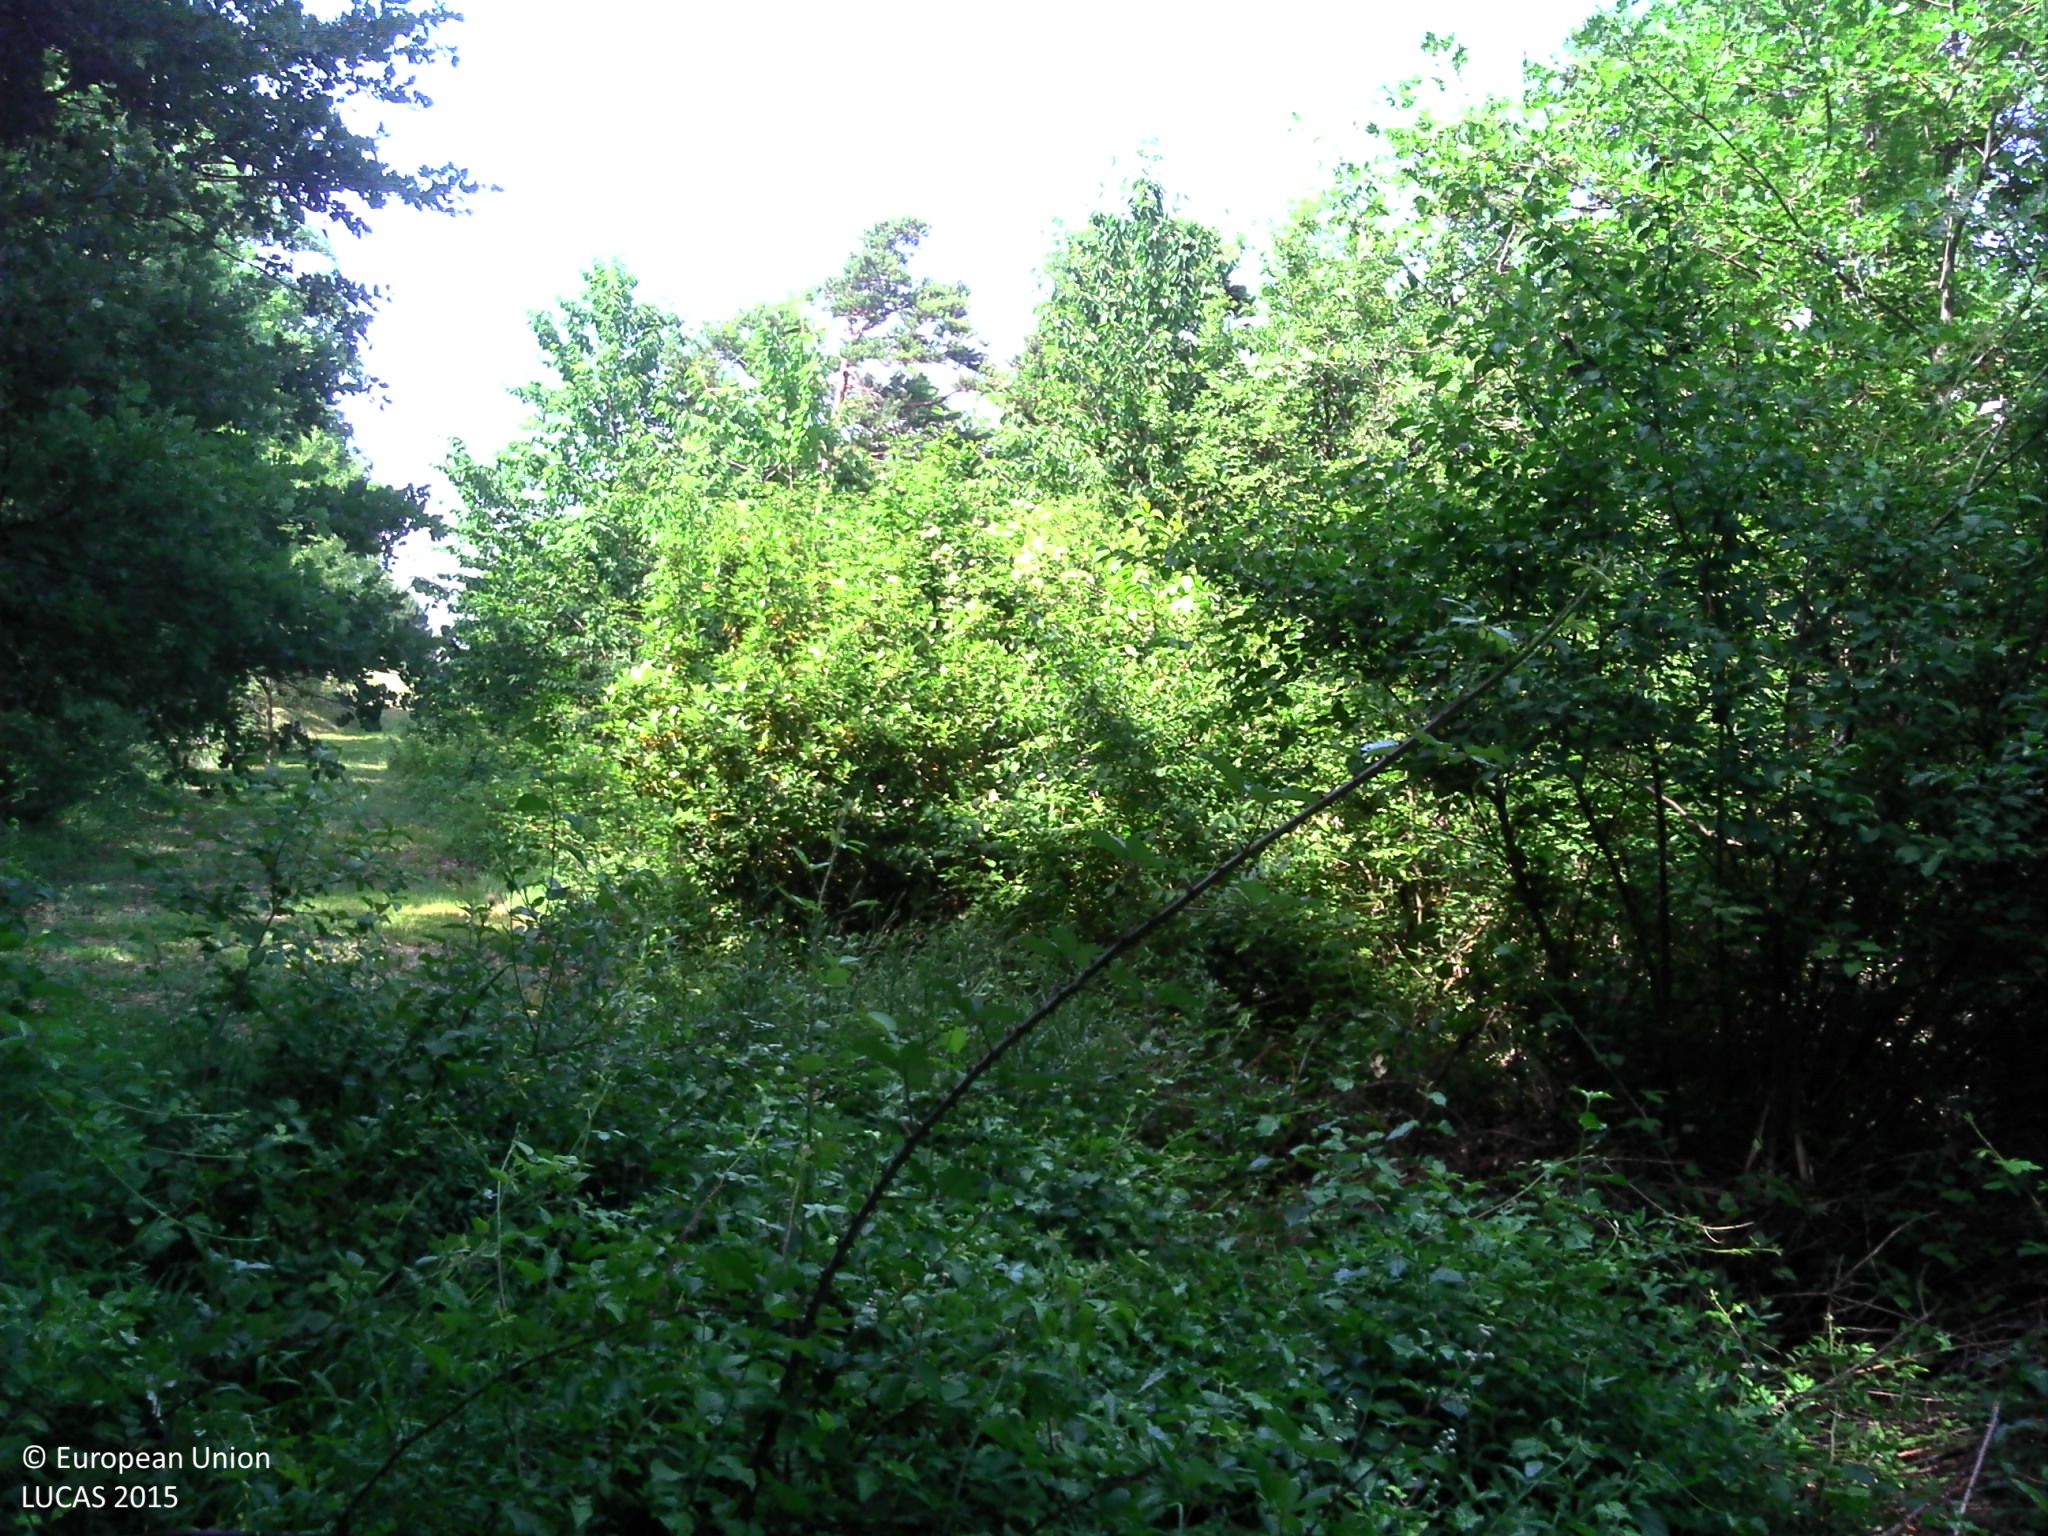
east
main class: Grassland
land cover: Grassland with sparse tree/shrub cover
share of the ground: > 75 %
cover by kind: herbaceous plants 90 %, broadleaved forest trees 5 %, shrubs 5 %
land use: Residential
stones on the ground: 25 - 50 %
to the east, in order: Grassland with sparse tree/shrub cover; Lines of trees; Fences; Grassland without tree/shrub cover; Broadleaved woodland; Other bare soil; Electric lines; Other bare soil
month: June
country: FR
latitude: 44.7151
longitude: 4.9443
